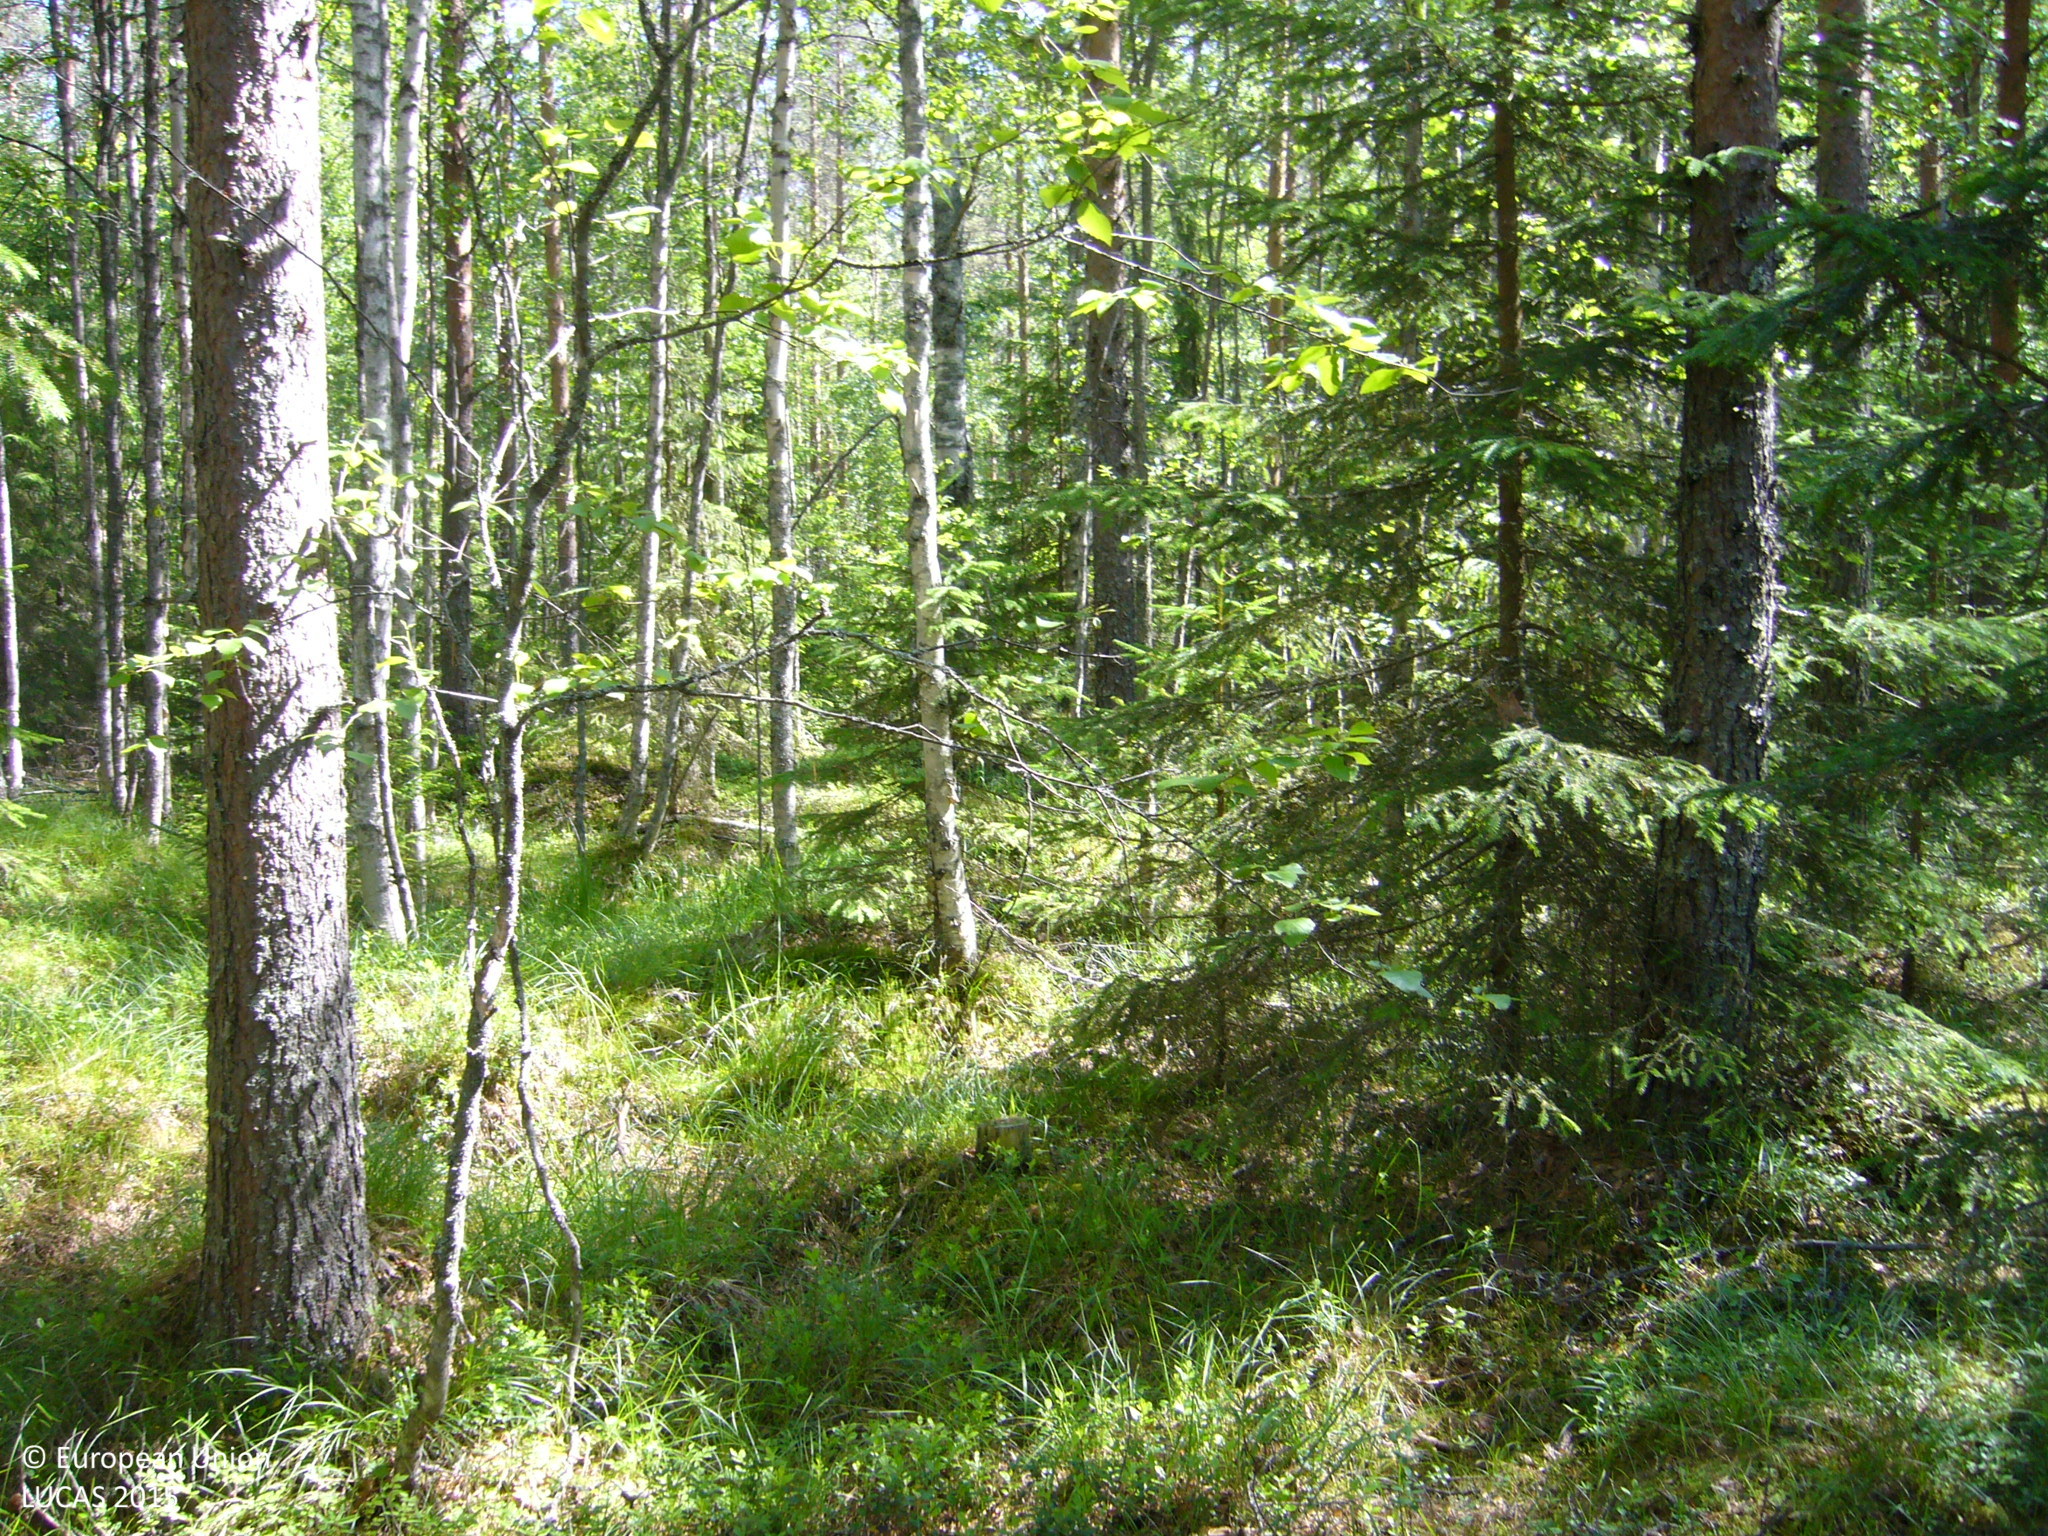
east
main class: Woodland
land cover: Pine dominated coniferous woodland
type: boreal forest
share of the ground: > 75 %
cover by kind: coniferous forest trees 60 %, shrubs 25 %, broadleaved forest trees 15 %
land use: Forestry
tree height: > 5 m
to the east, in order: Pine dominated coniferous woodland; Ditches and canals; Pine dominated mixed woodland; Ditches and canals; Pine dominated mixed woodland; Ditches and canals; Pine dominated mixed woodland; Ditches and canals; Pine dominated mixed woodland
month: July
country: FI
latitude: 63.3895
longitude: 25.8596
